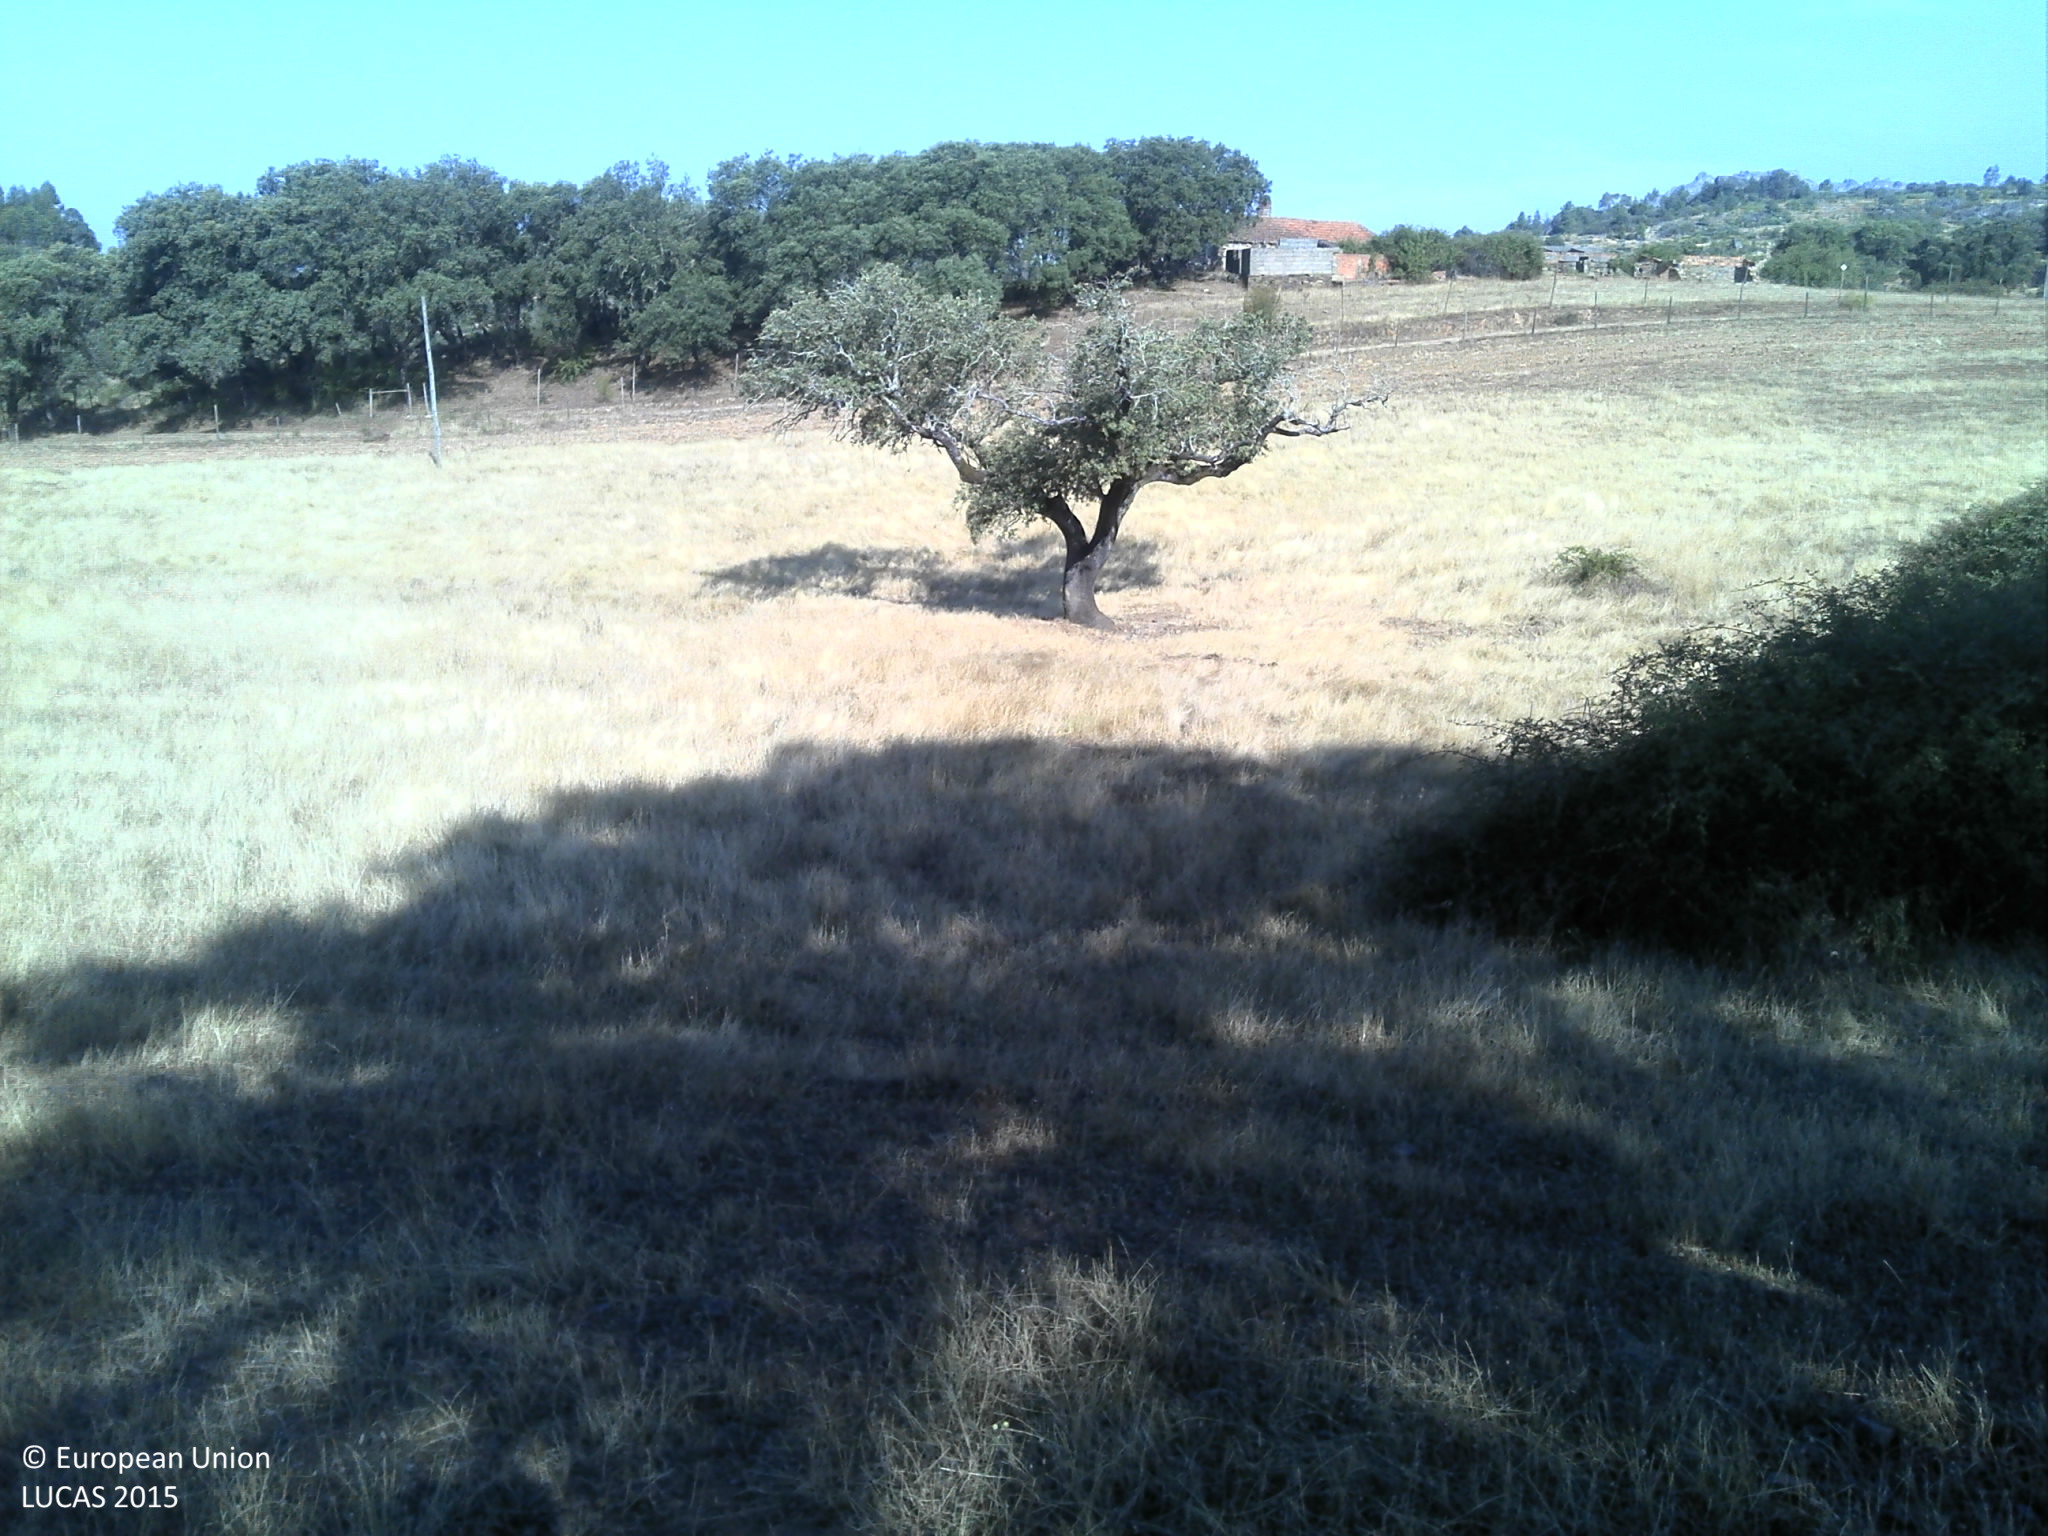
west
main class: Grassland
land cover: Grassland with sparse tree/shrub cover
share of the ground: 25 - 50 %
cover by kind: herbaceous plants 60 %, unconsolidated bare surface 30 %, broadleaved forest trees 5 %
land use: Agriculture (excluding fallow land and kitchen gardens)
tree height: > 5 m
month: June
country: PT
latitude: 40.0132
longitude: -7.0681
